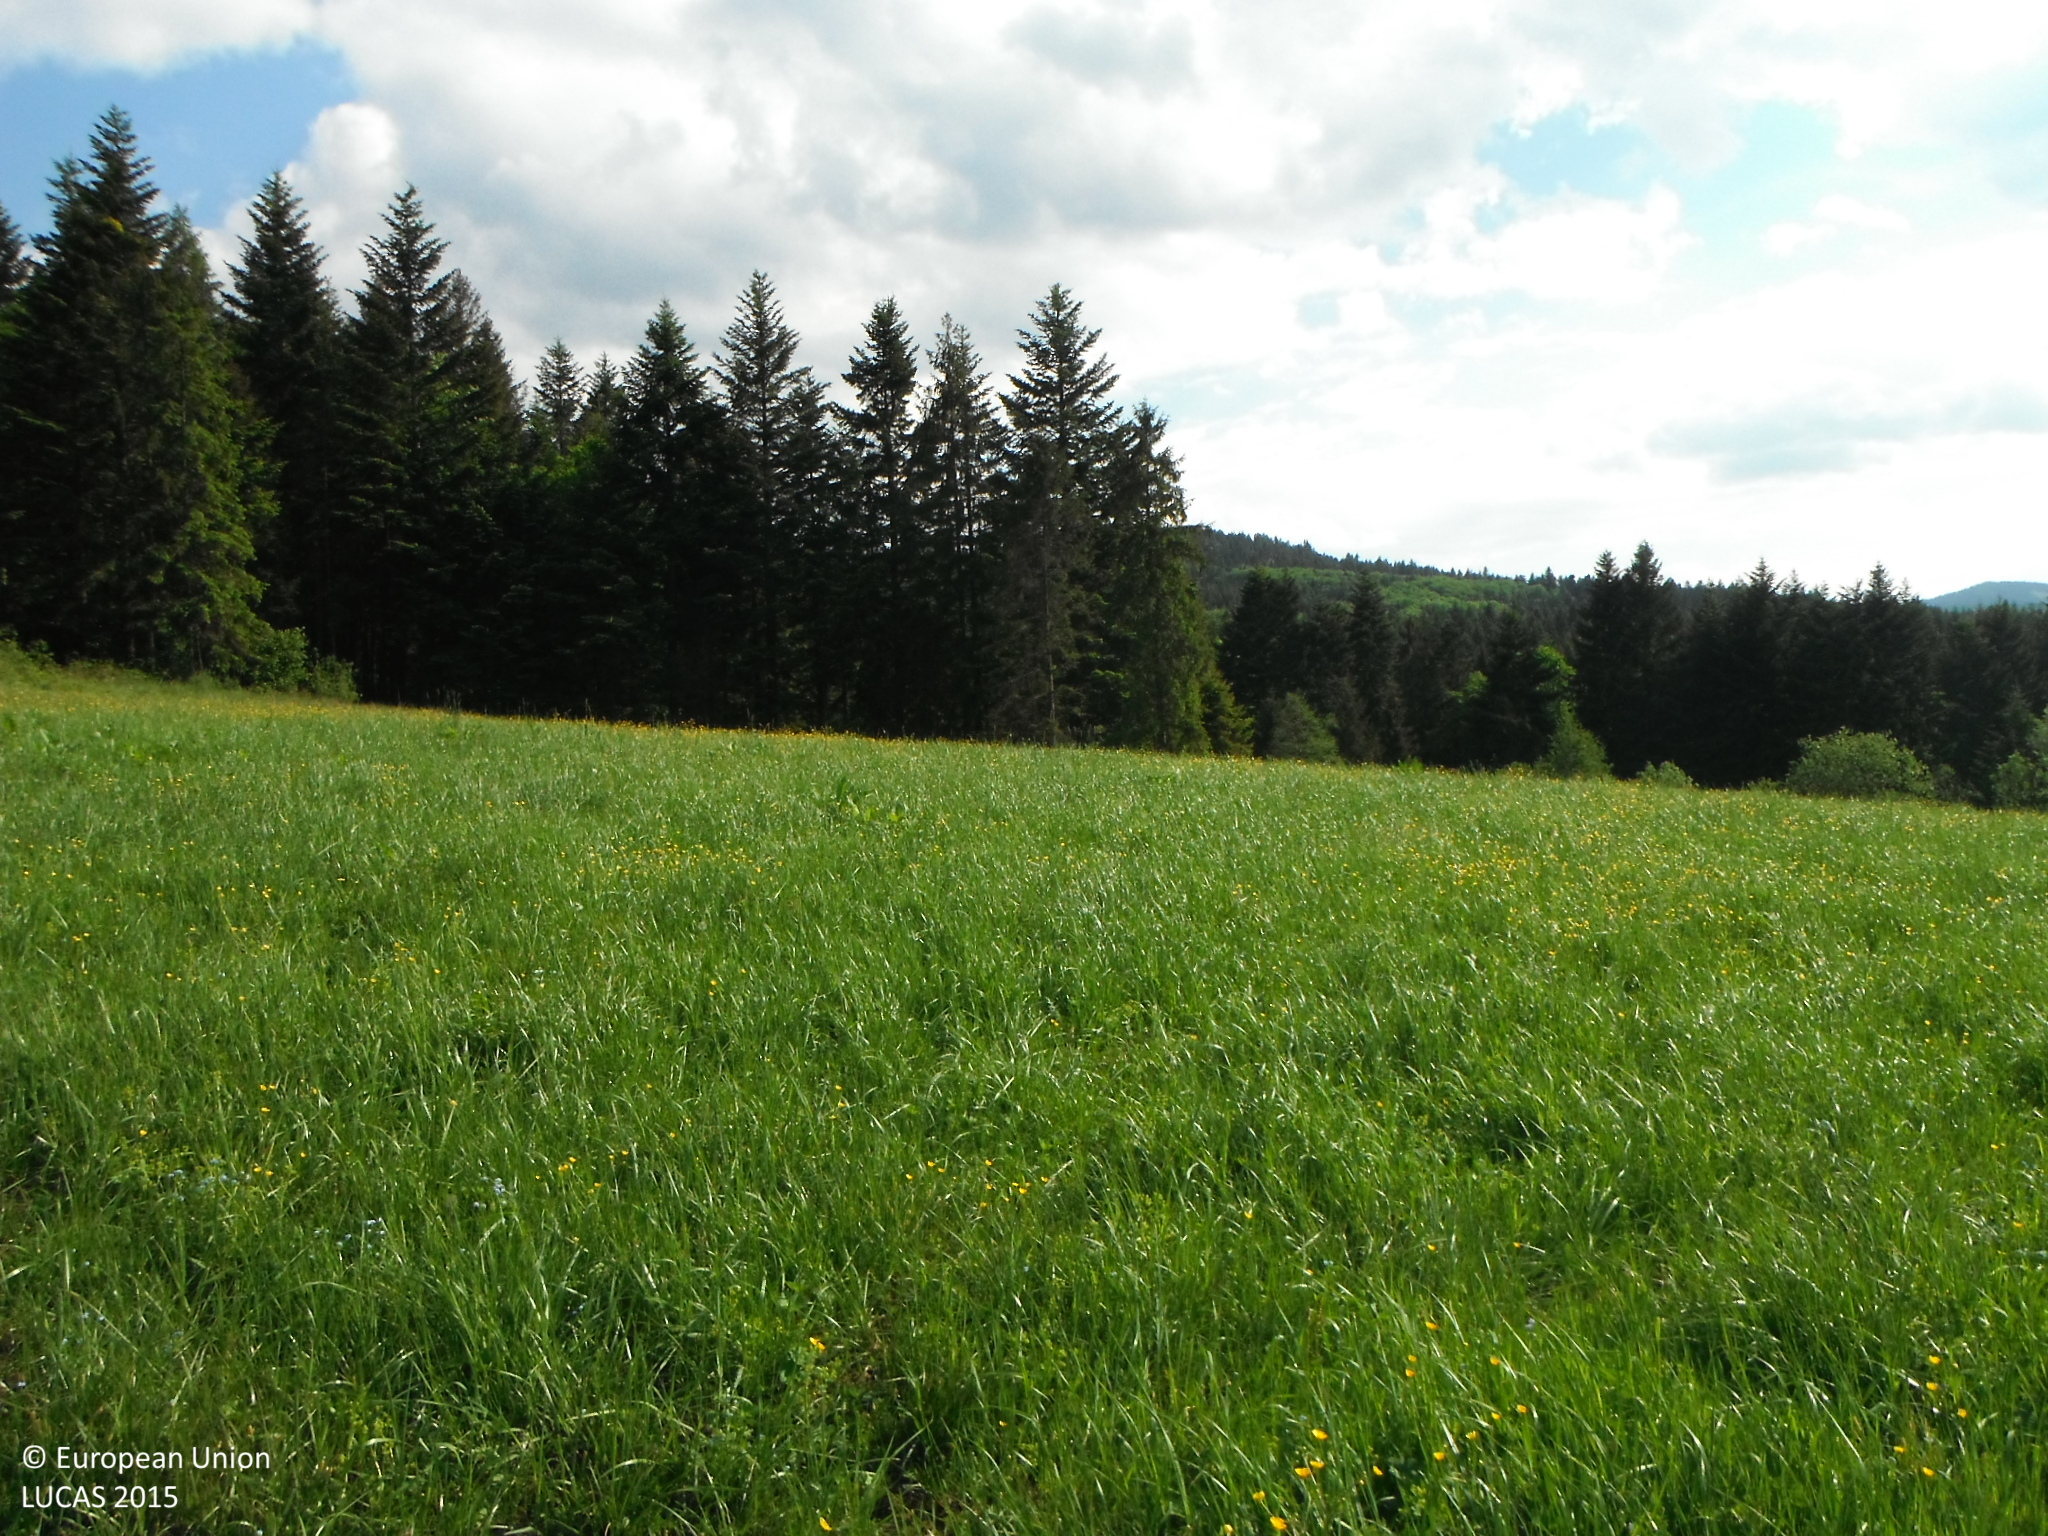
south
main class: Grassland
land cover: Grassland without tree/shrub cover
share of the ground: > 75 %
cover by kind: herbaceous plants 100 %
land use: Agriculture (excluding fallow land and kitchen gardens)
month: May
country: SK
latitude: 49.2755
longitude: 20.7468
